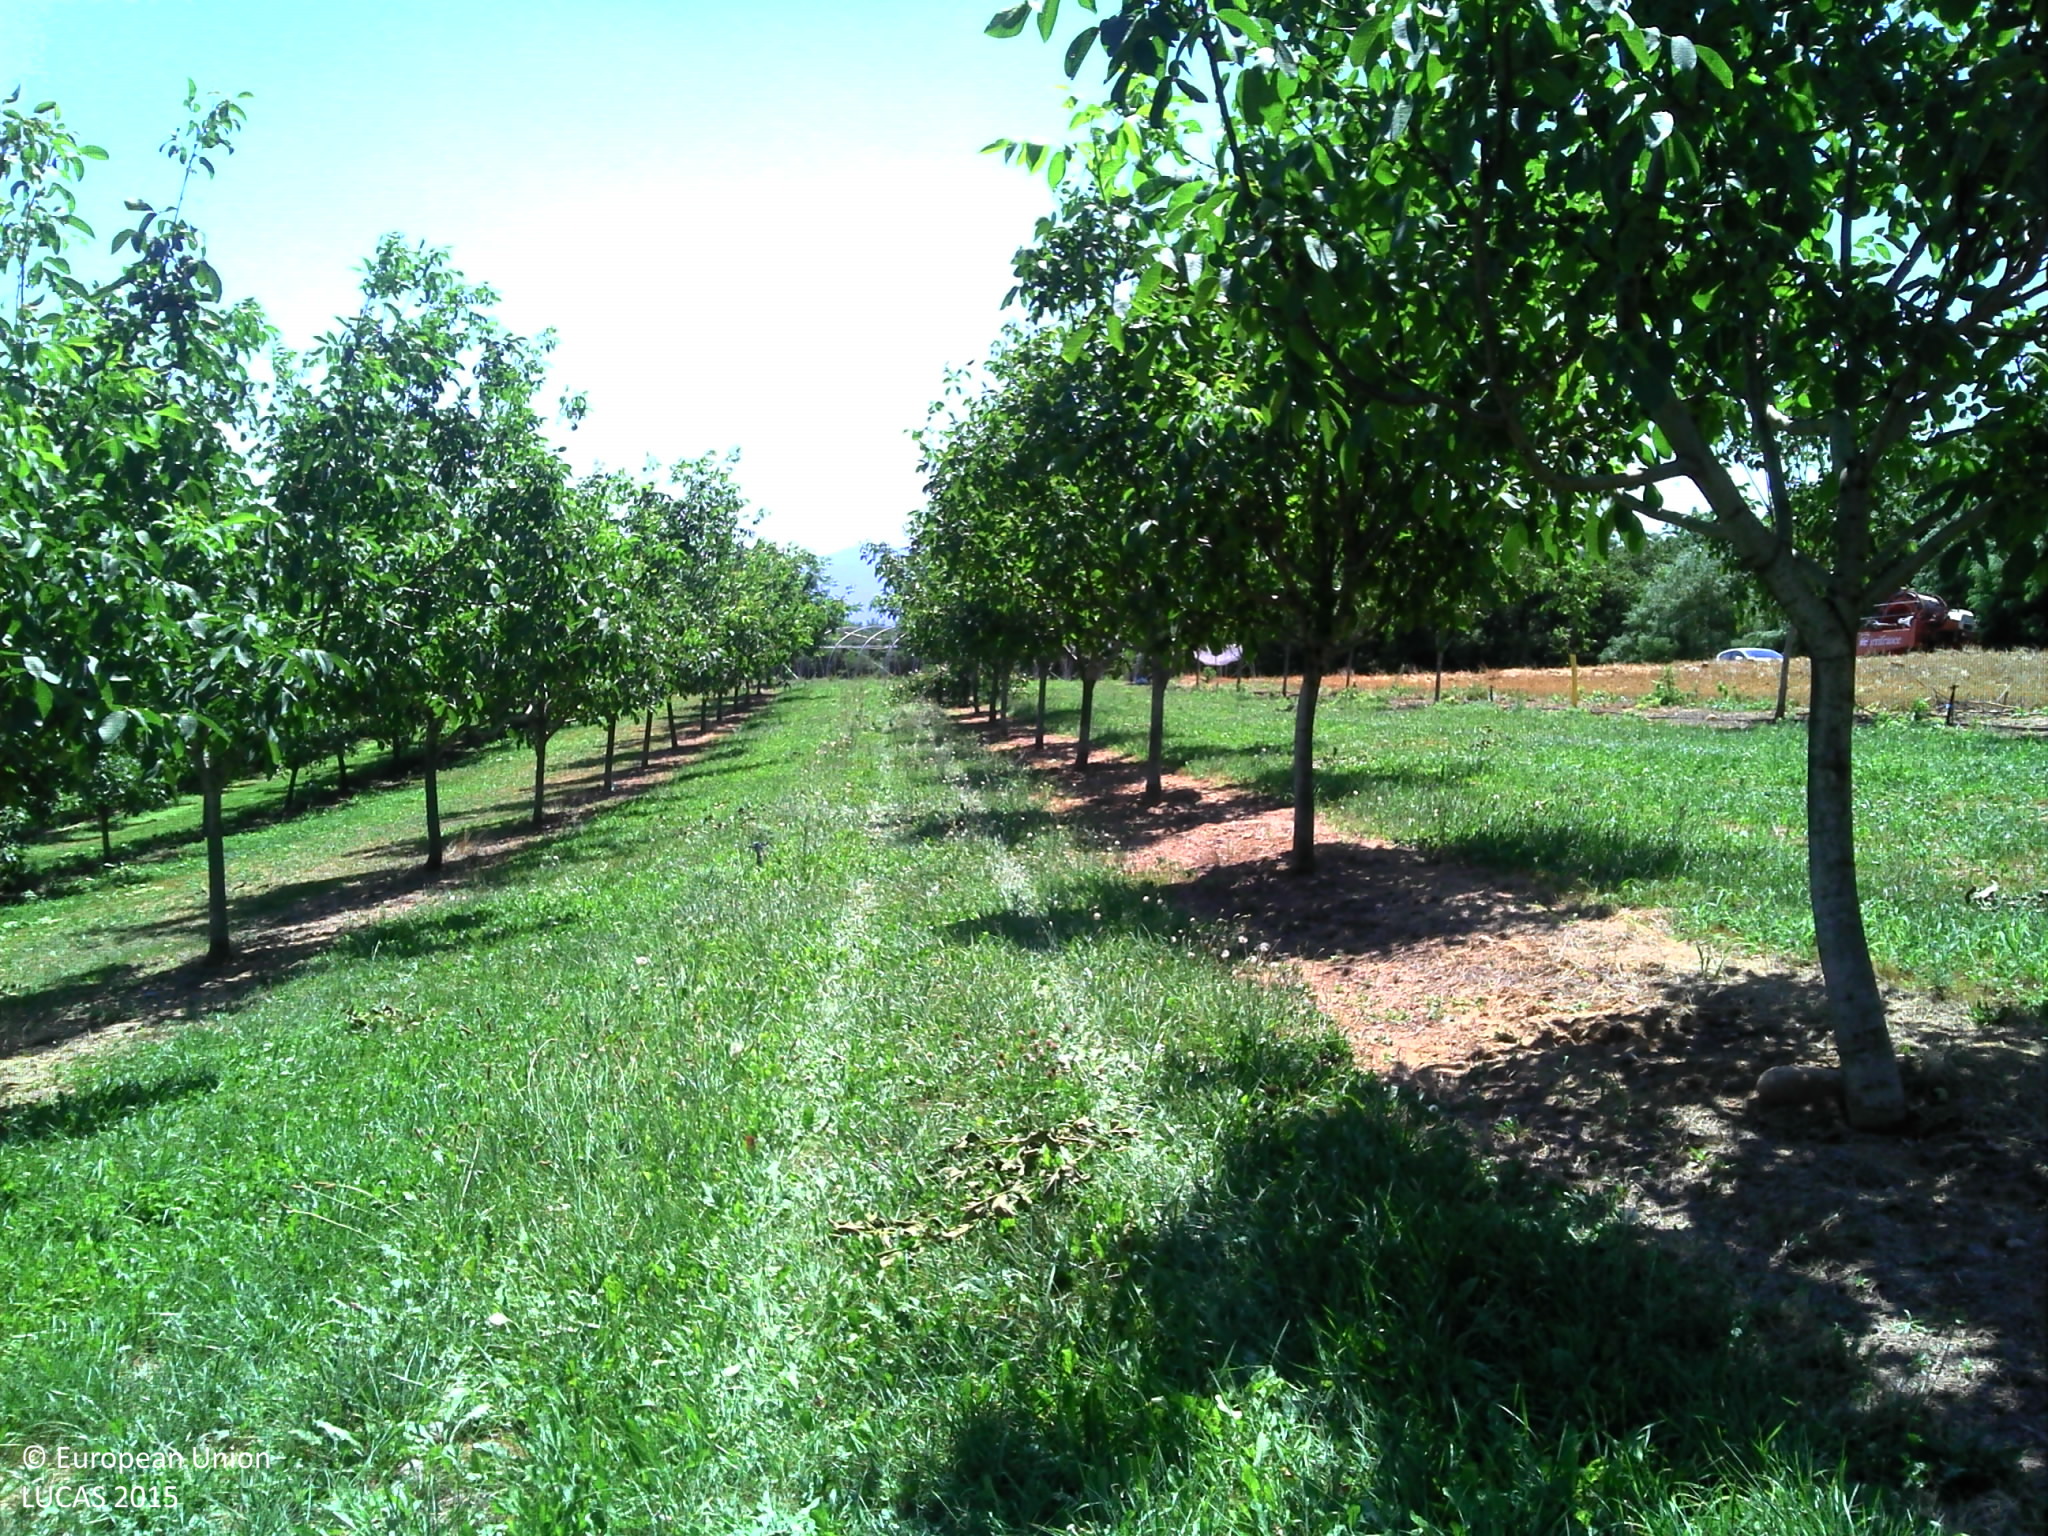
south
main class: Cropland
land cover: Nuts trees
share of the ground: 25 - 50 %
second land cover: Grassland without tree/shrub cover
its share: > 75 %
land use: Agriculture (excluding fallow land and kitchen gardens)
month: July
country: FR
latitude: 45.1430
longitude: 5.2108
